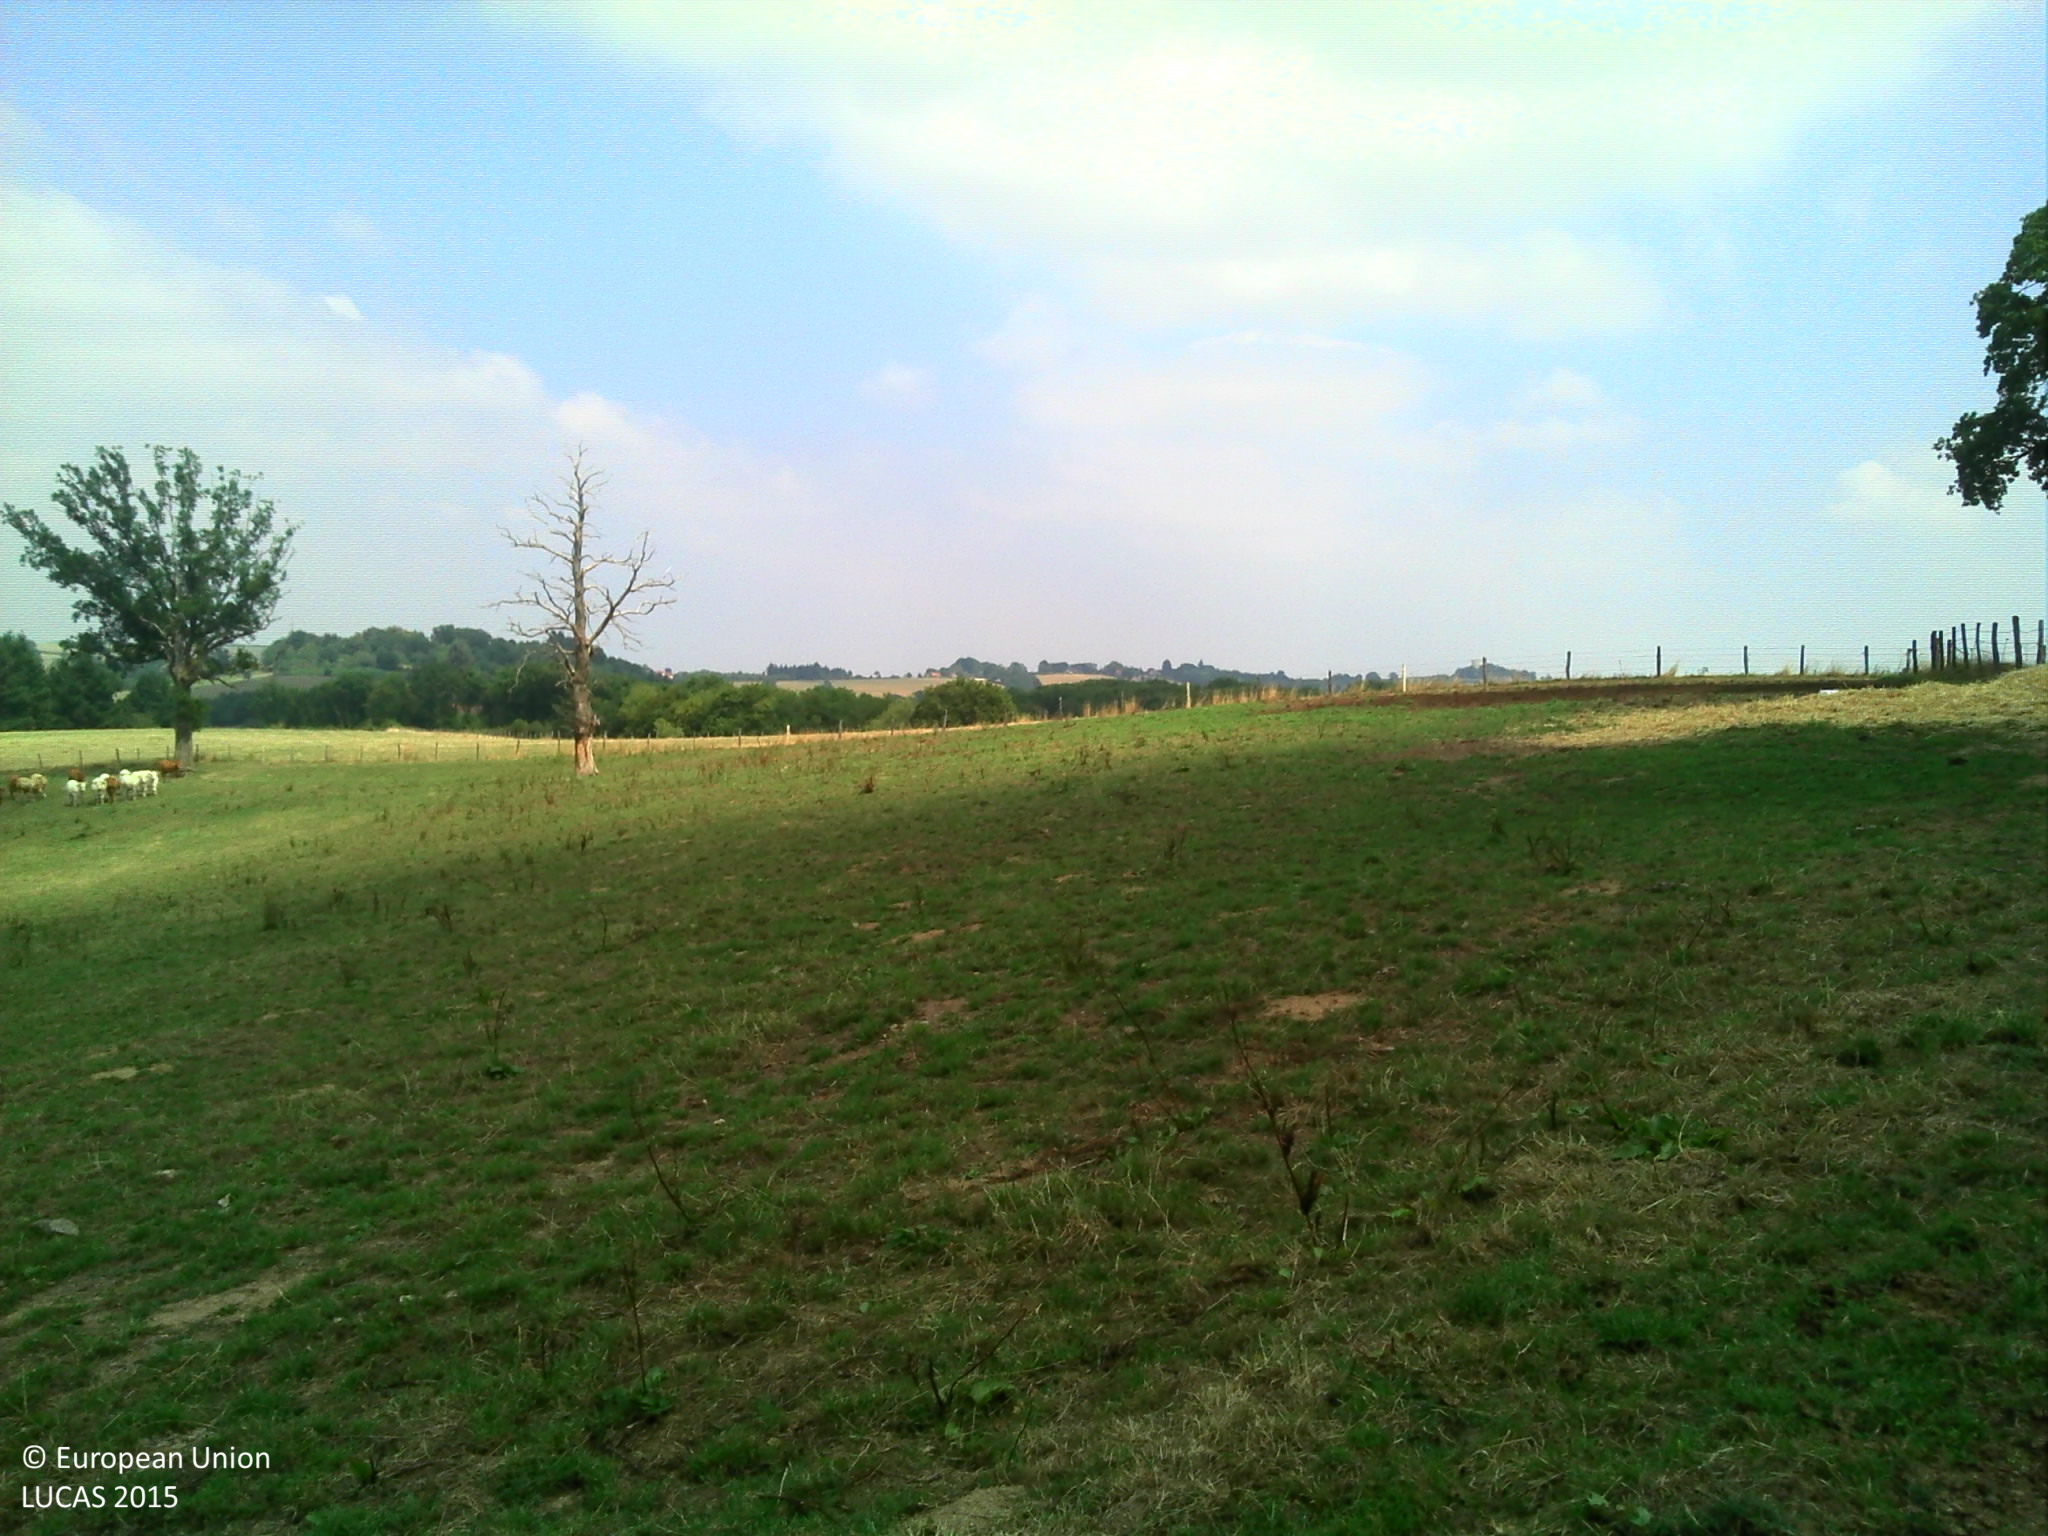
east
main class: Grassland
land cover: Grassland without tree/shrub cover
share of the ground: > 75 %
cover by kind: herbaceous plants 100 %
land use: Agriculture (excluding fallow land and kitchen gardens)
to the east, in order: Grassland without tree/shrub cover; Fences; Grassland without tree/shrub cover; Fences; Grassland without tree/shrub cover
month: August
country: FR
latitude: 46.3445
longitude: 3.6721
